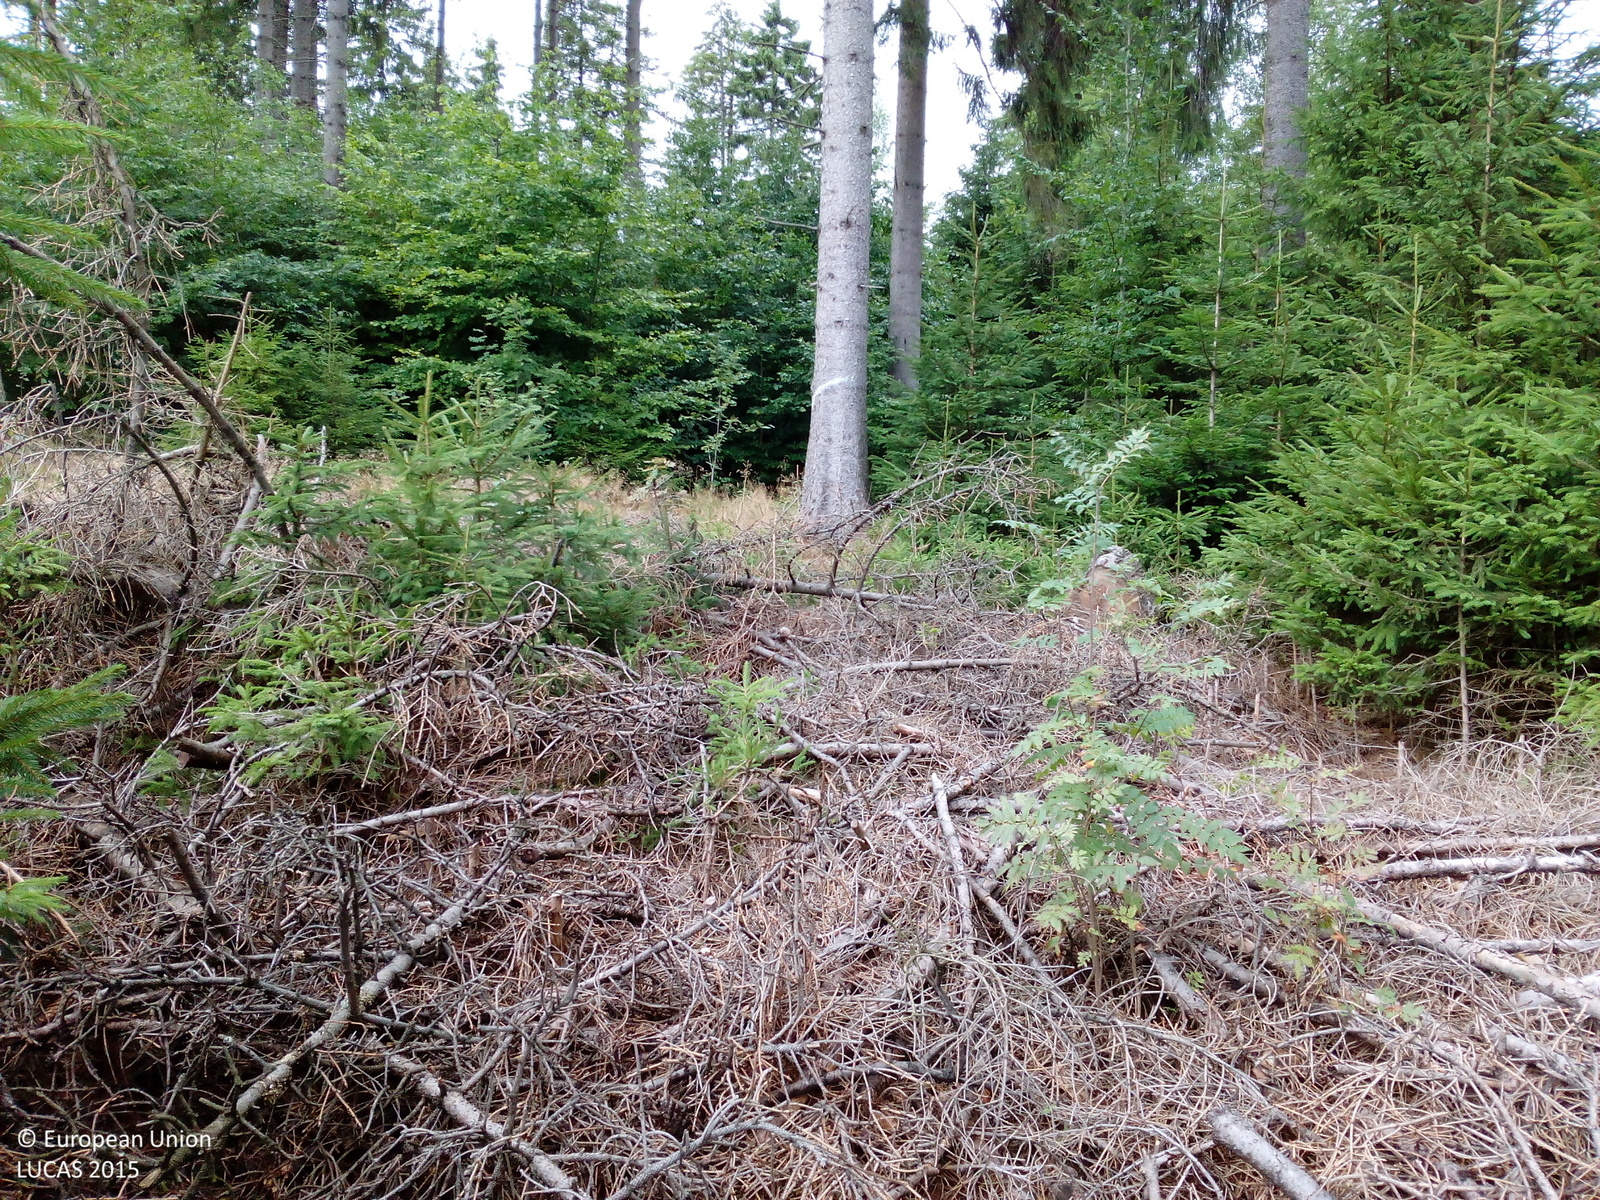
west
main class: Woodland
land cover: Spruce dominated coniferous woodland
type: hemiboreal forest and nemoral coniferous forest and mixed broadleaved-coniferous forest
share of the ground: > 75 %
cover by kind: coniferous forest trees 90 %
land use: Forestry
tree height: < 5 m
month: August
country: DE
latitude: 50.3890
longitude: 11.5890
